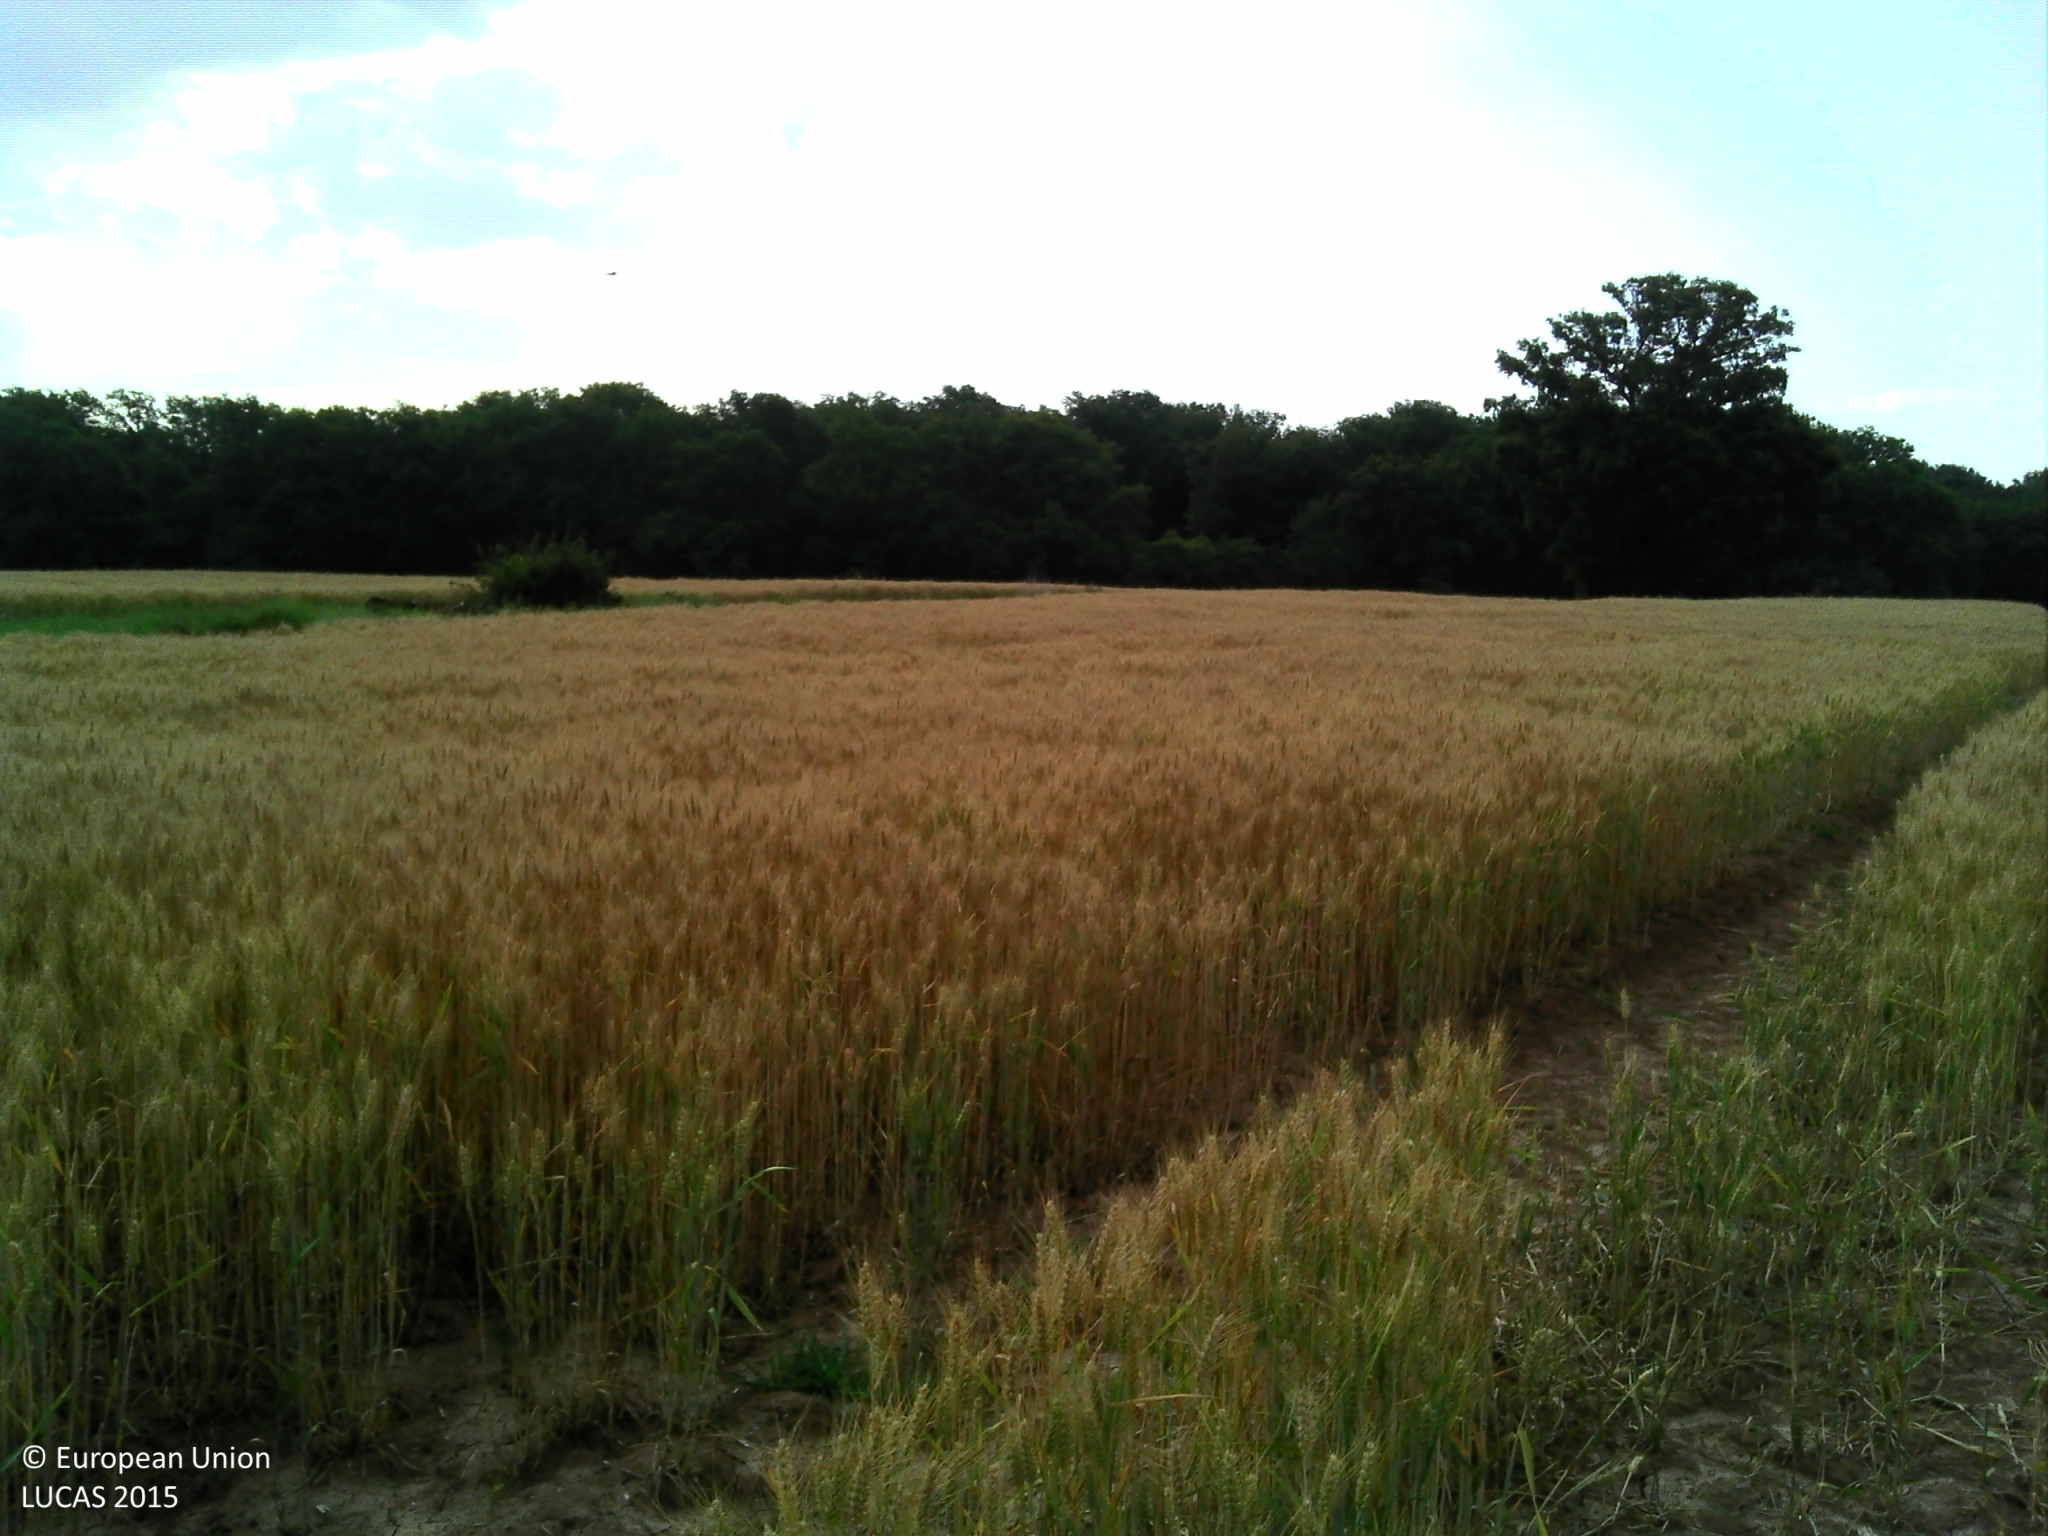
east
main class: Cropland
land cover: Common wheat
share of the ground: > 75 %
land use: Agriculture (excluding fallow land and kitchen gardens)
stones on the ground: < 10 %
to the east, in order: Common wheat; Grass margins; Common wheat; Grassland without tree/shrub cover; Fences; Broadleaved woodland
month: July
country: FR
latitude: 47.0976
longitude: 3.5812
